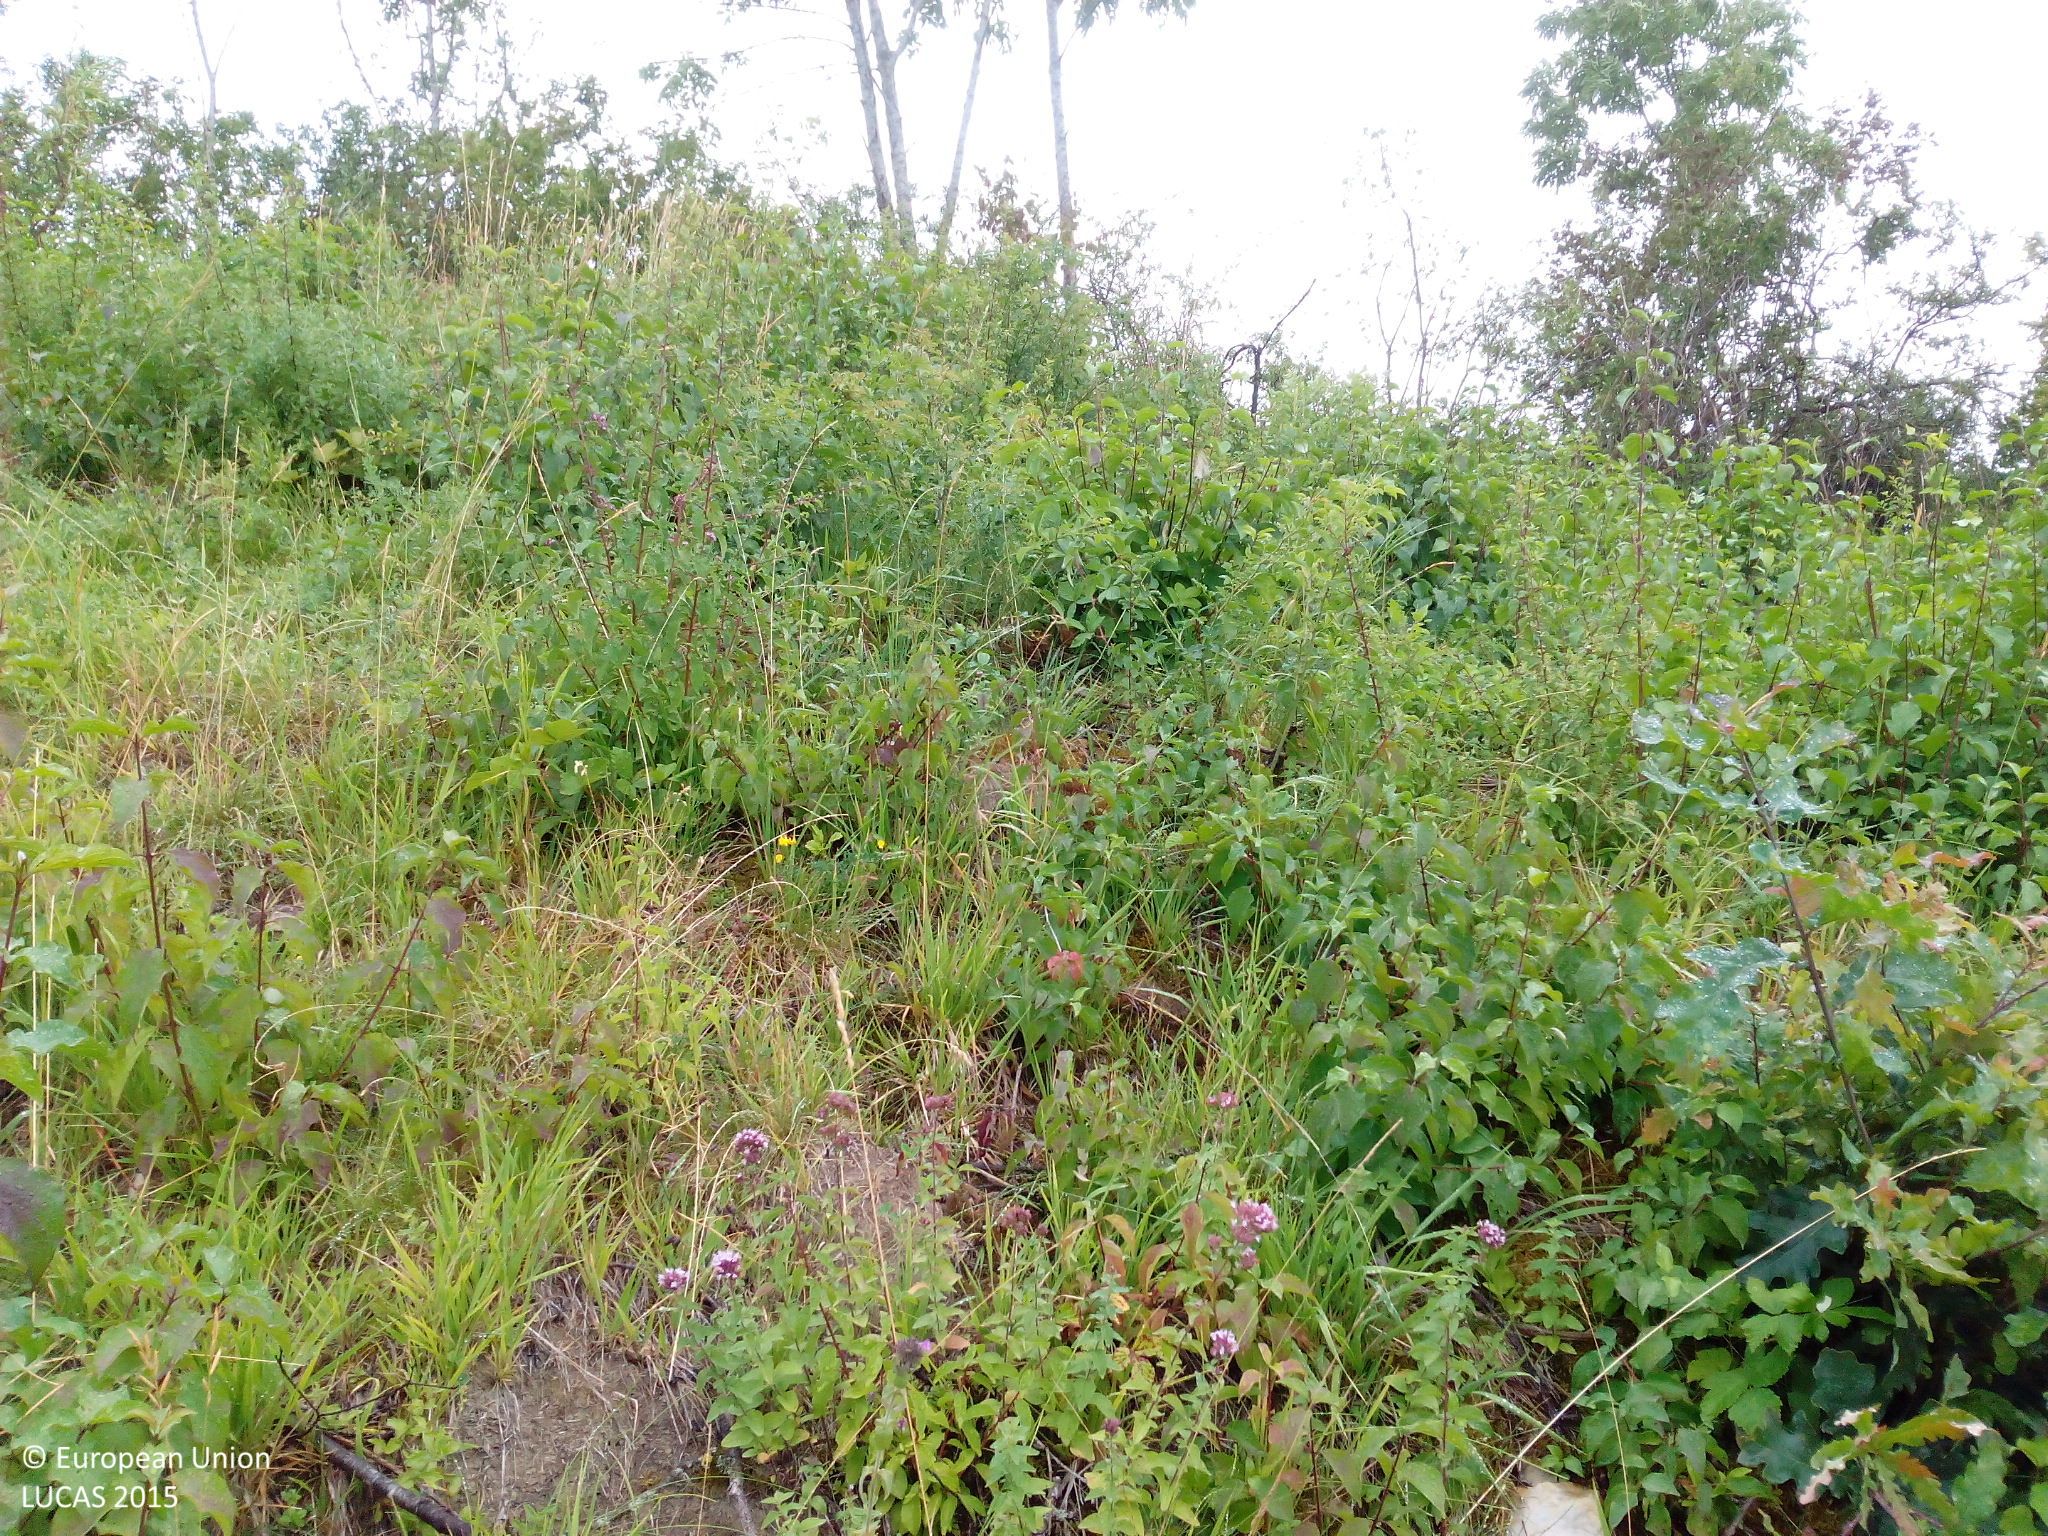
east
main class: Shrubland
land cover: Shrubland with sparse tree cover
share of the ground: > 75 %
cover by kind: herbaceous plants 60 %, shrubs 30 %, broadleaved forest trees 5 %, unconsolidated bare surface 5 %
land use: Semi-natural and natural areas not in use
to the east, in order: Shrubland with sparse tree cover; Broadleaved woodland; Grassland without tree/shrub cover; Grassland with sparse tree/shrub cover; Tracks; Grassland without tree/shrub cover
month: July
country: DE
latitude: 48.8710
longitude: 10.2589
